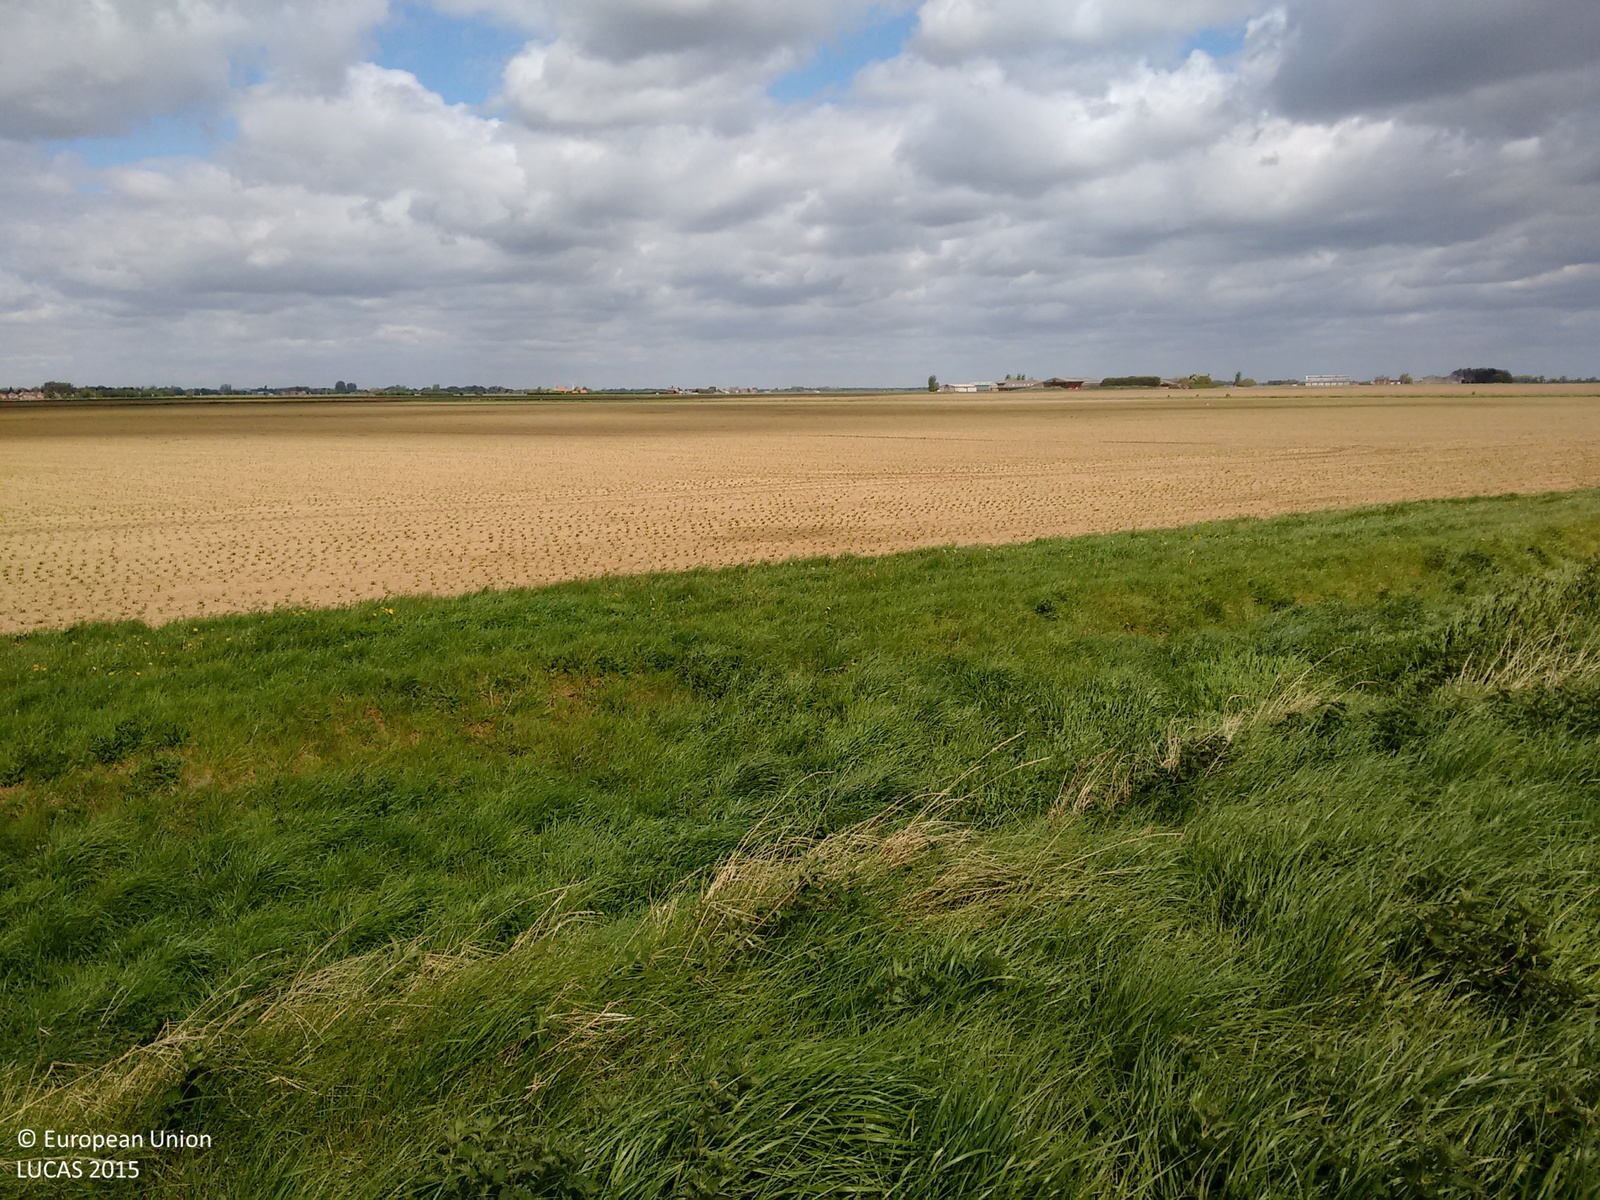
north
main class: Grassland
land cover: Grassland without tree/shrub cover
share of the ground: > 75 %
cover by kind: herbaceous plants 100 %
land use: Semi-natural and natural areas not in use
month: May
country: GB
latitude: 53.0803
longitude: 0.2521
